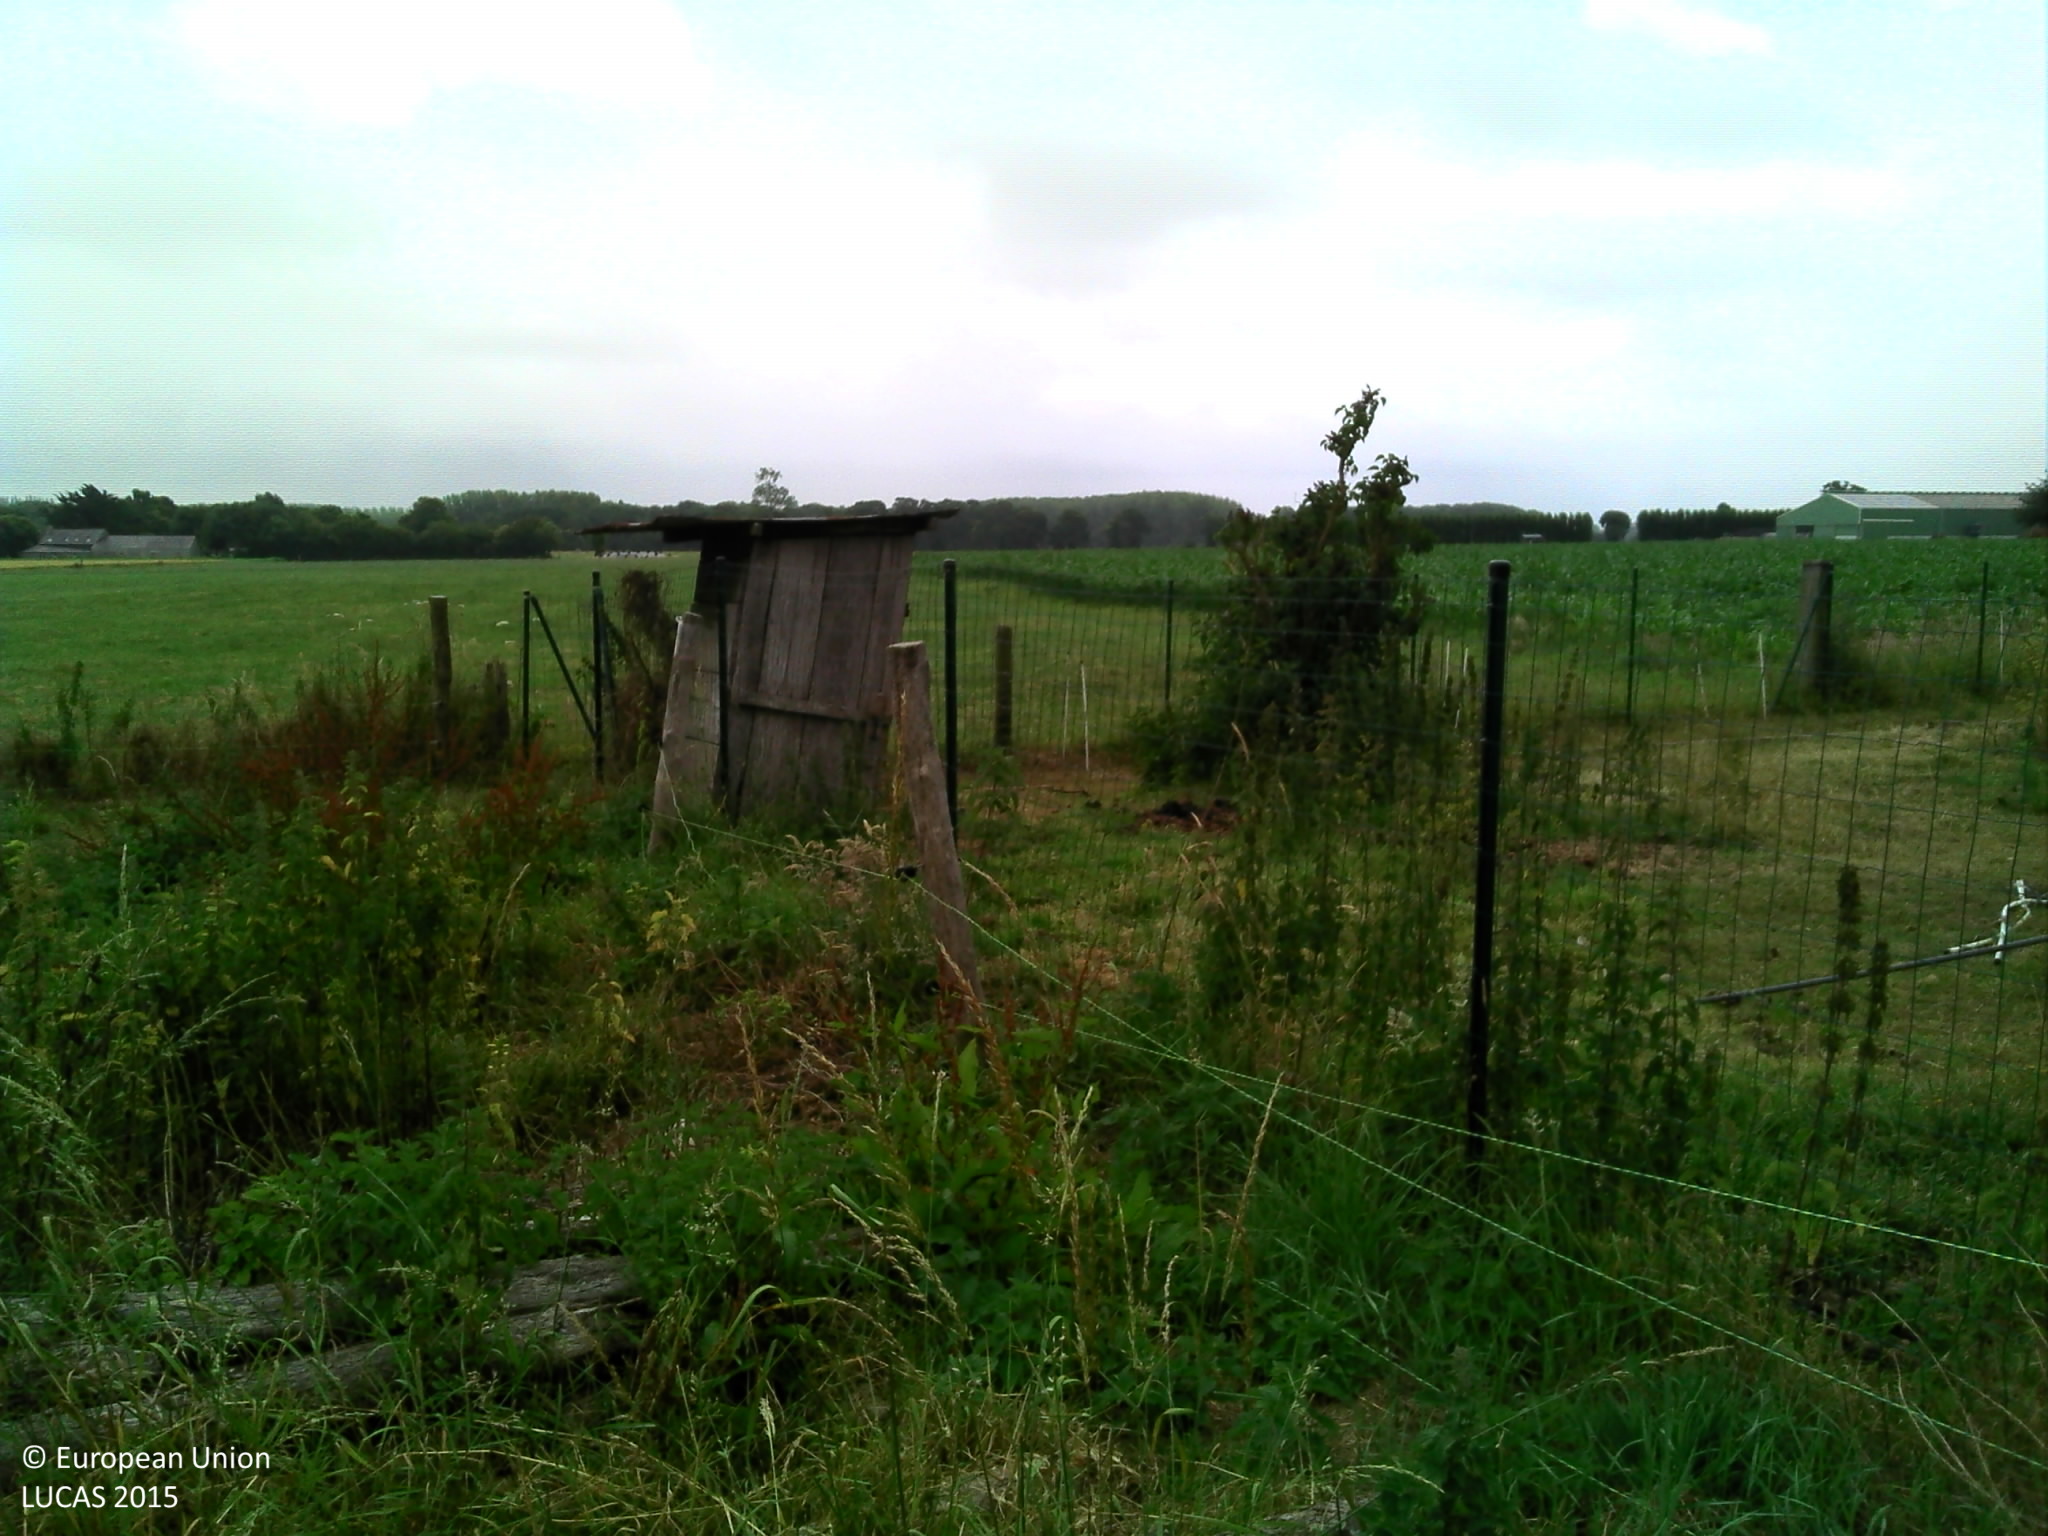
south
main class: Grassland
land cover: Grassland without tree/shrub cover
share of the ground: > 75 %
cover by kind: herbaceous plants 80 %, lichens and mosses 10 %, unconsolidated bare surface 10 %
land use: Agriculture (excluding fallow land and kitchen gardens)
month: July
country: FR
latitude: 48.5871
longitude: -2.3008
